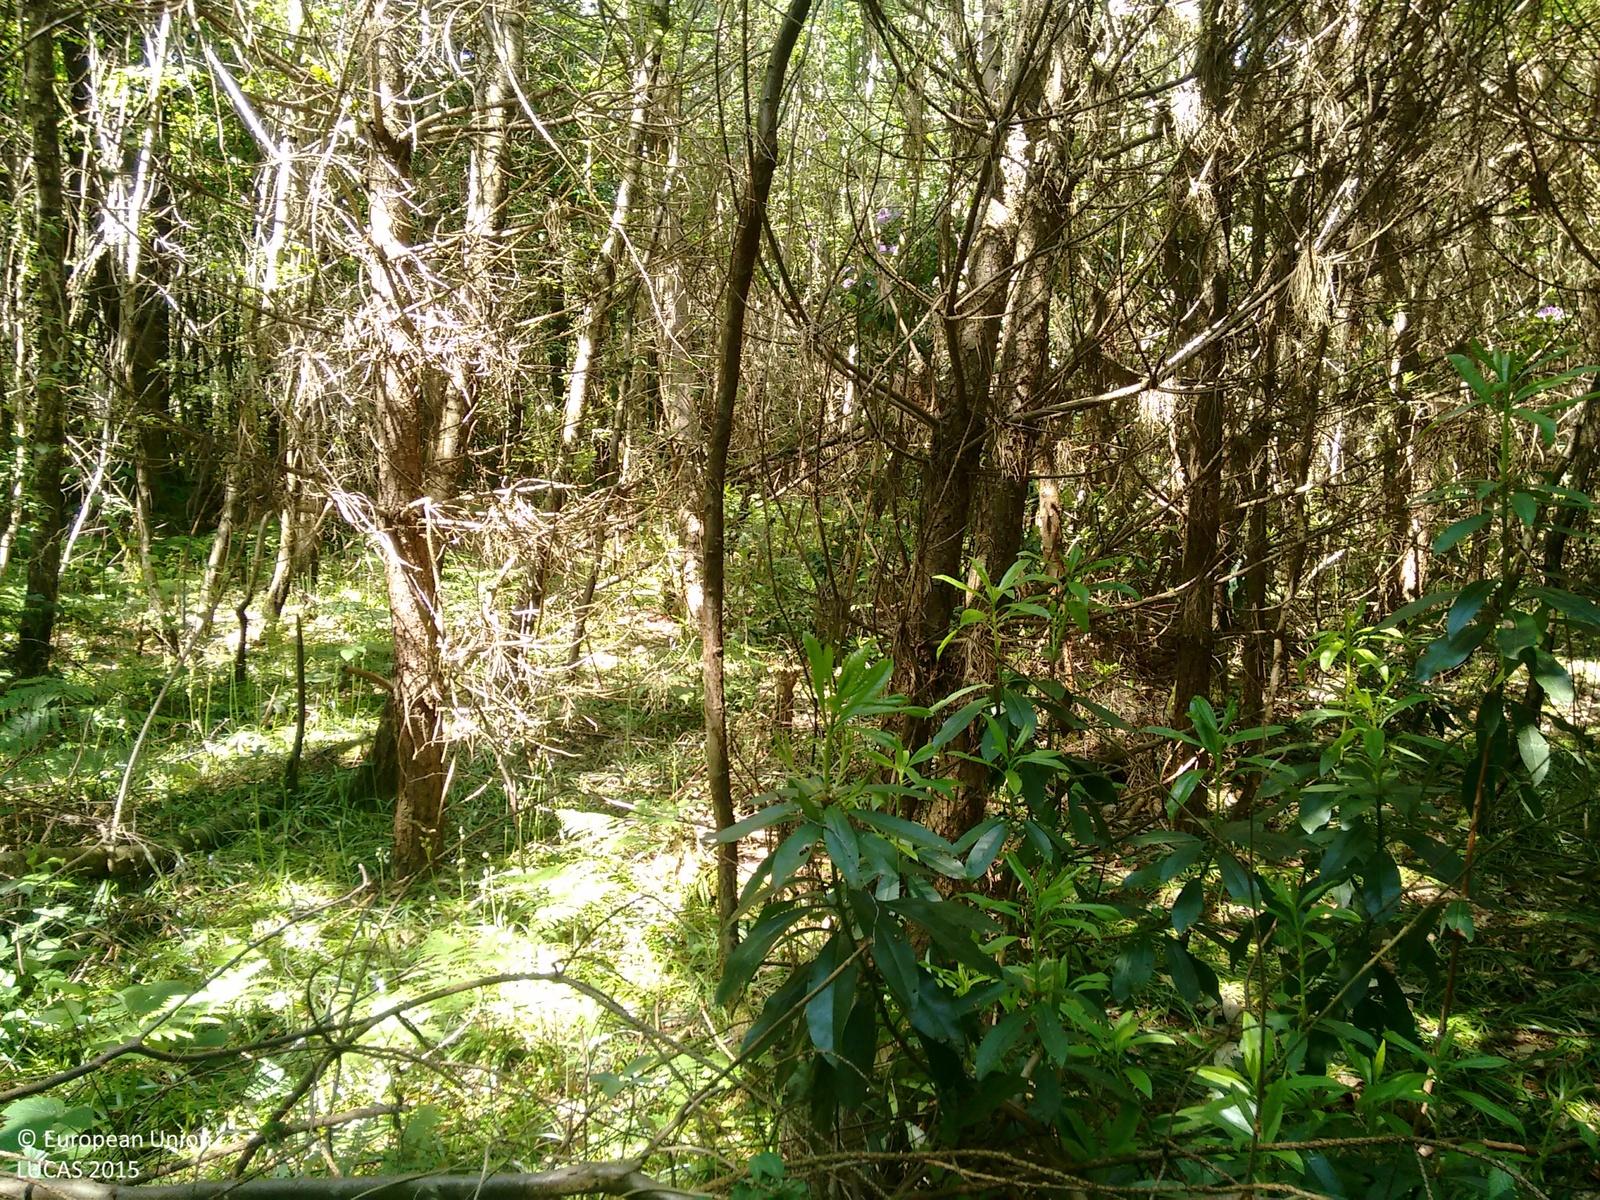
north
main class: Woodland
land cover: Other mixed woodland
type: exotic forest
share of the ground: > 75 %
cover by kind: coniferous forest trees 70 %, broadleaved forest trees 30 %
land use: Forestry
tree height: > 5 m
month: June
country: GB
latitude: 51.0708
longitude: 0.4814
